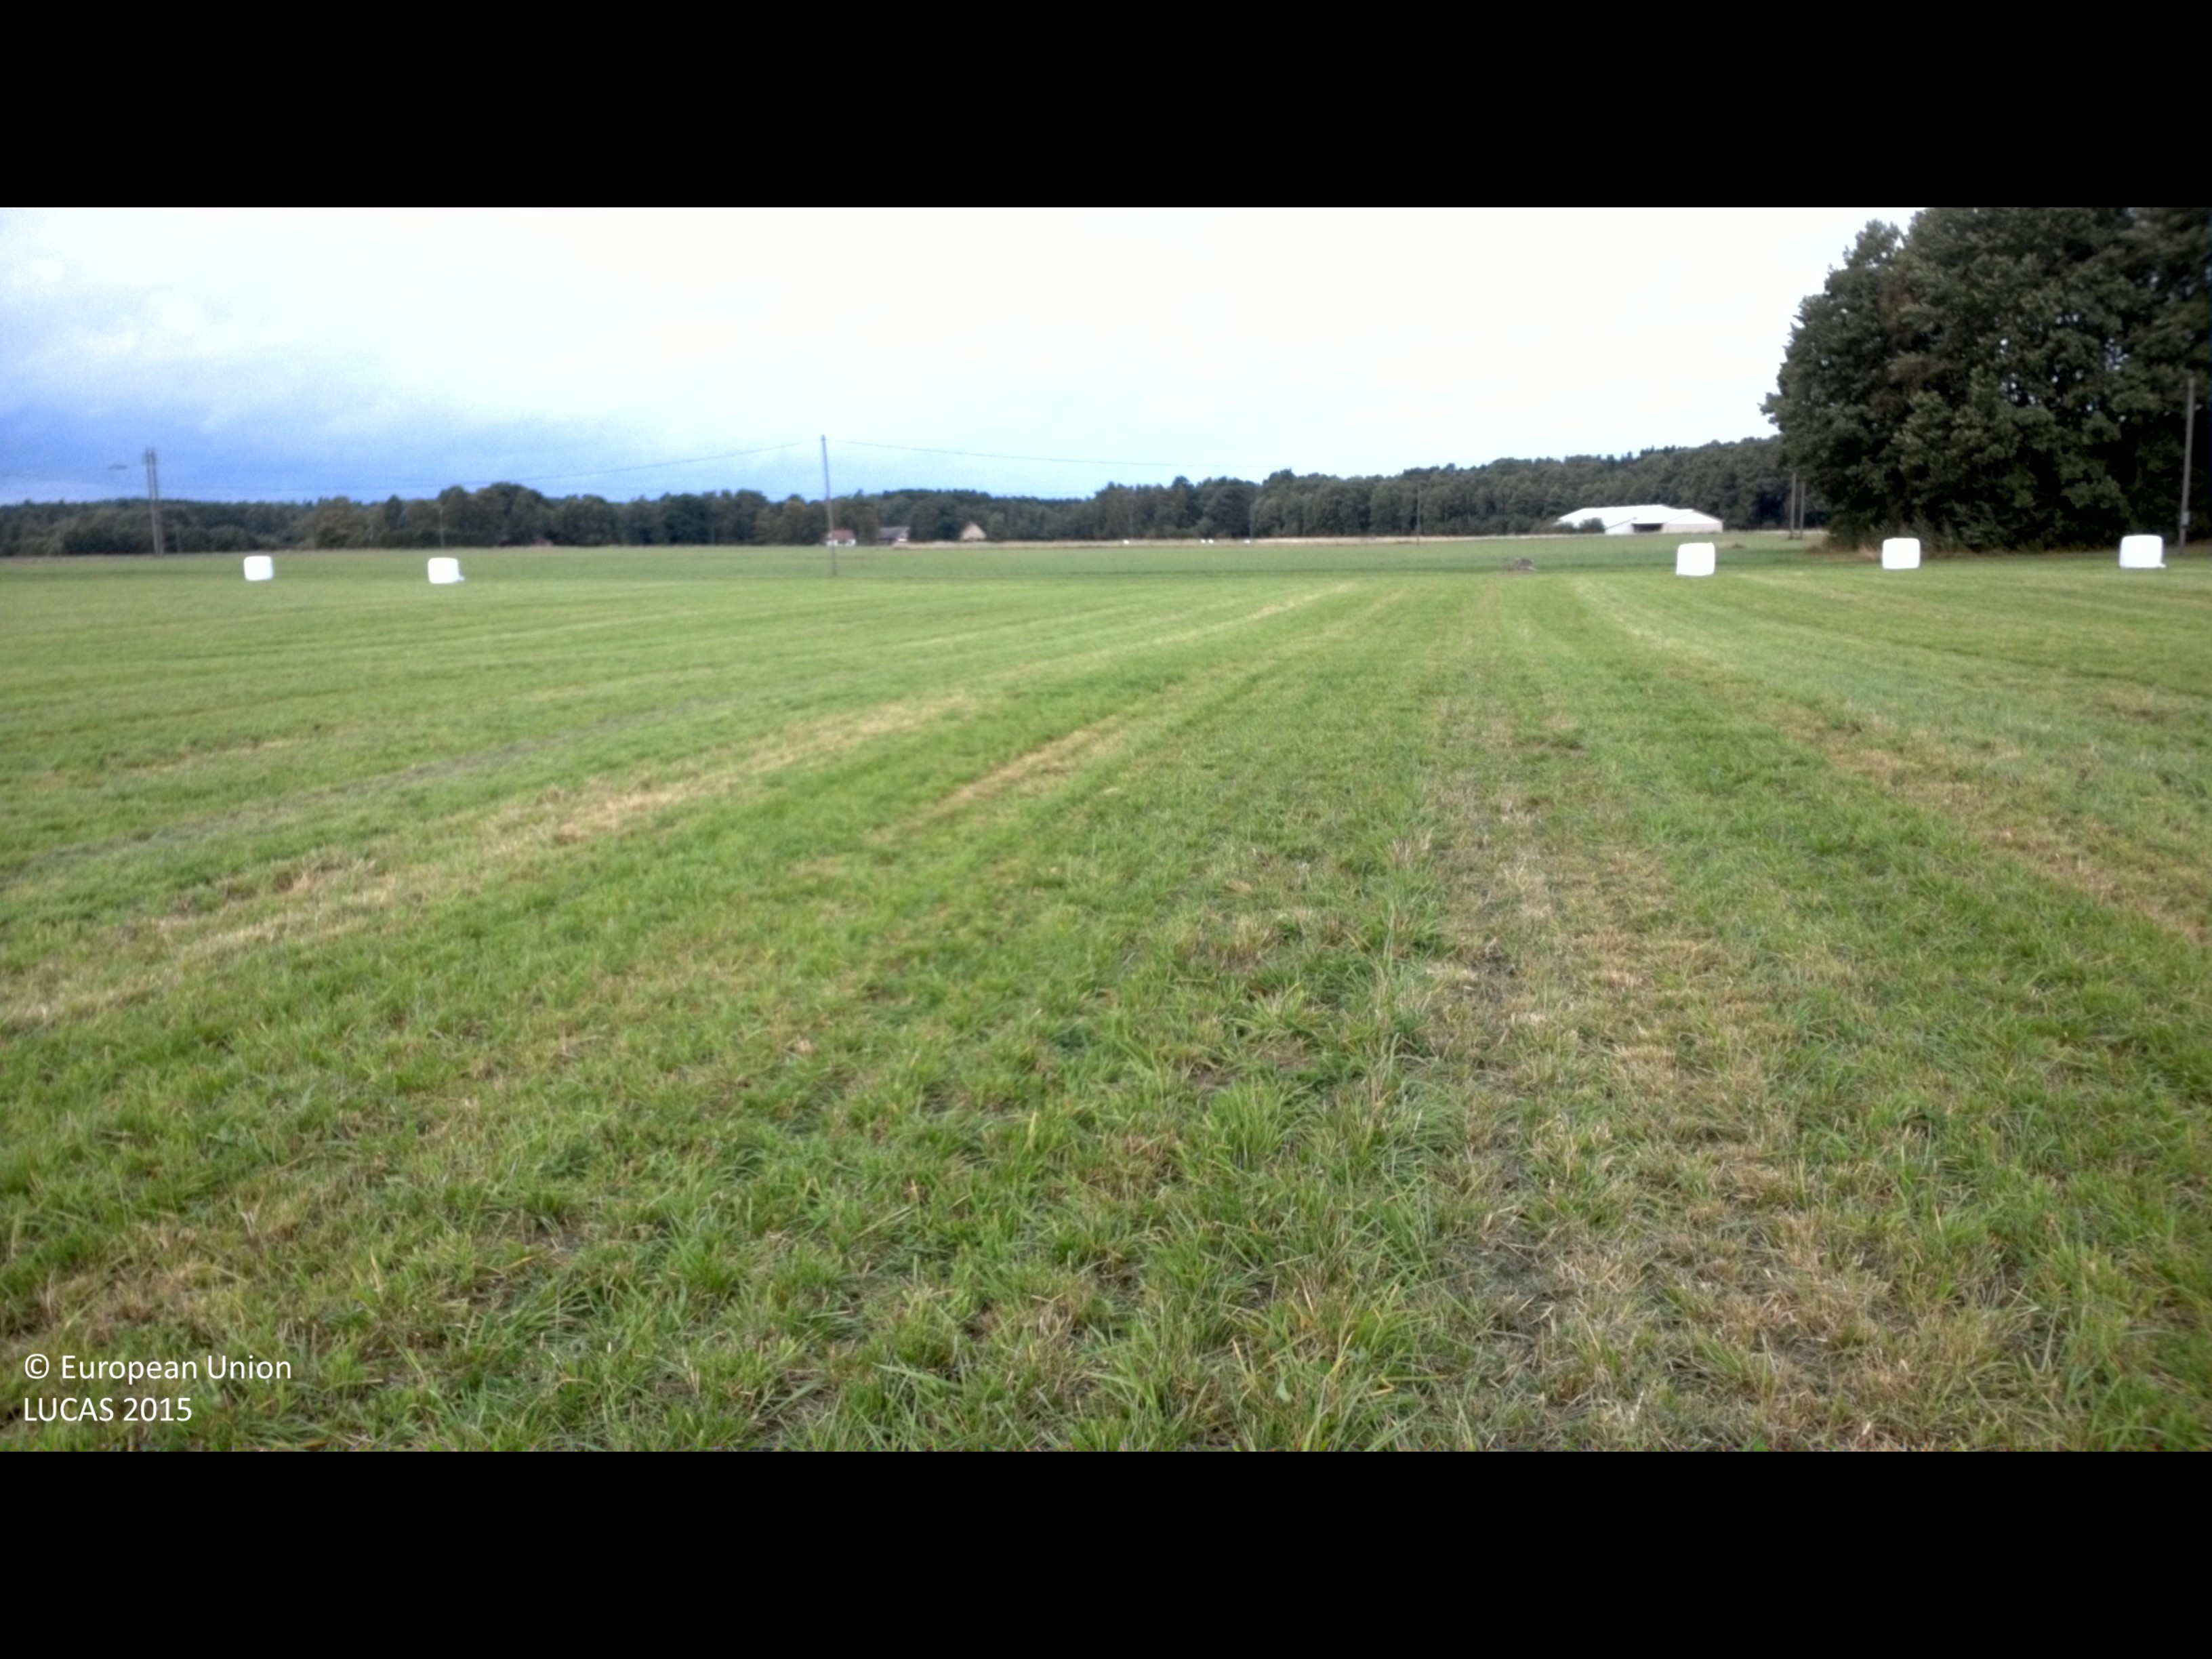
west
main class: Cropland
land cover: Temporary grasslands
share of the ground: > 75 %
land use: Agriculture (excluding fallow land and kitchen gardens)
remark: Harvested field
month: September
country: SE
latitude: 56.2120
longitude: 14.1090
